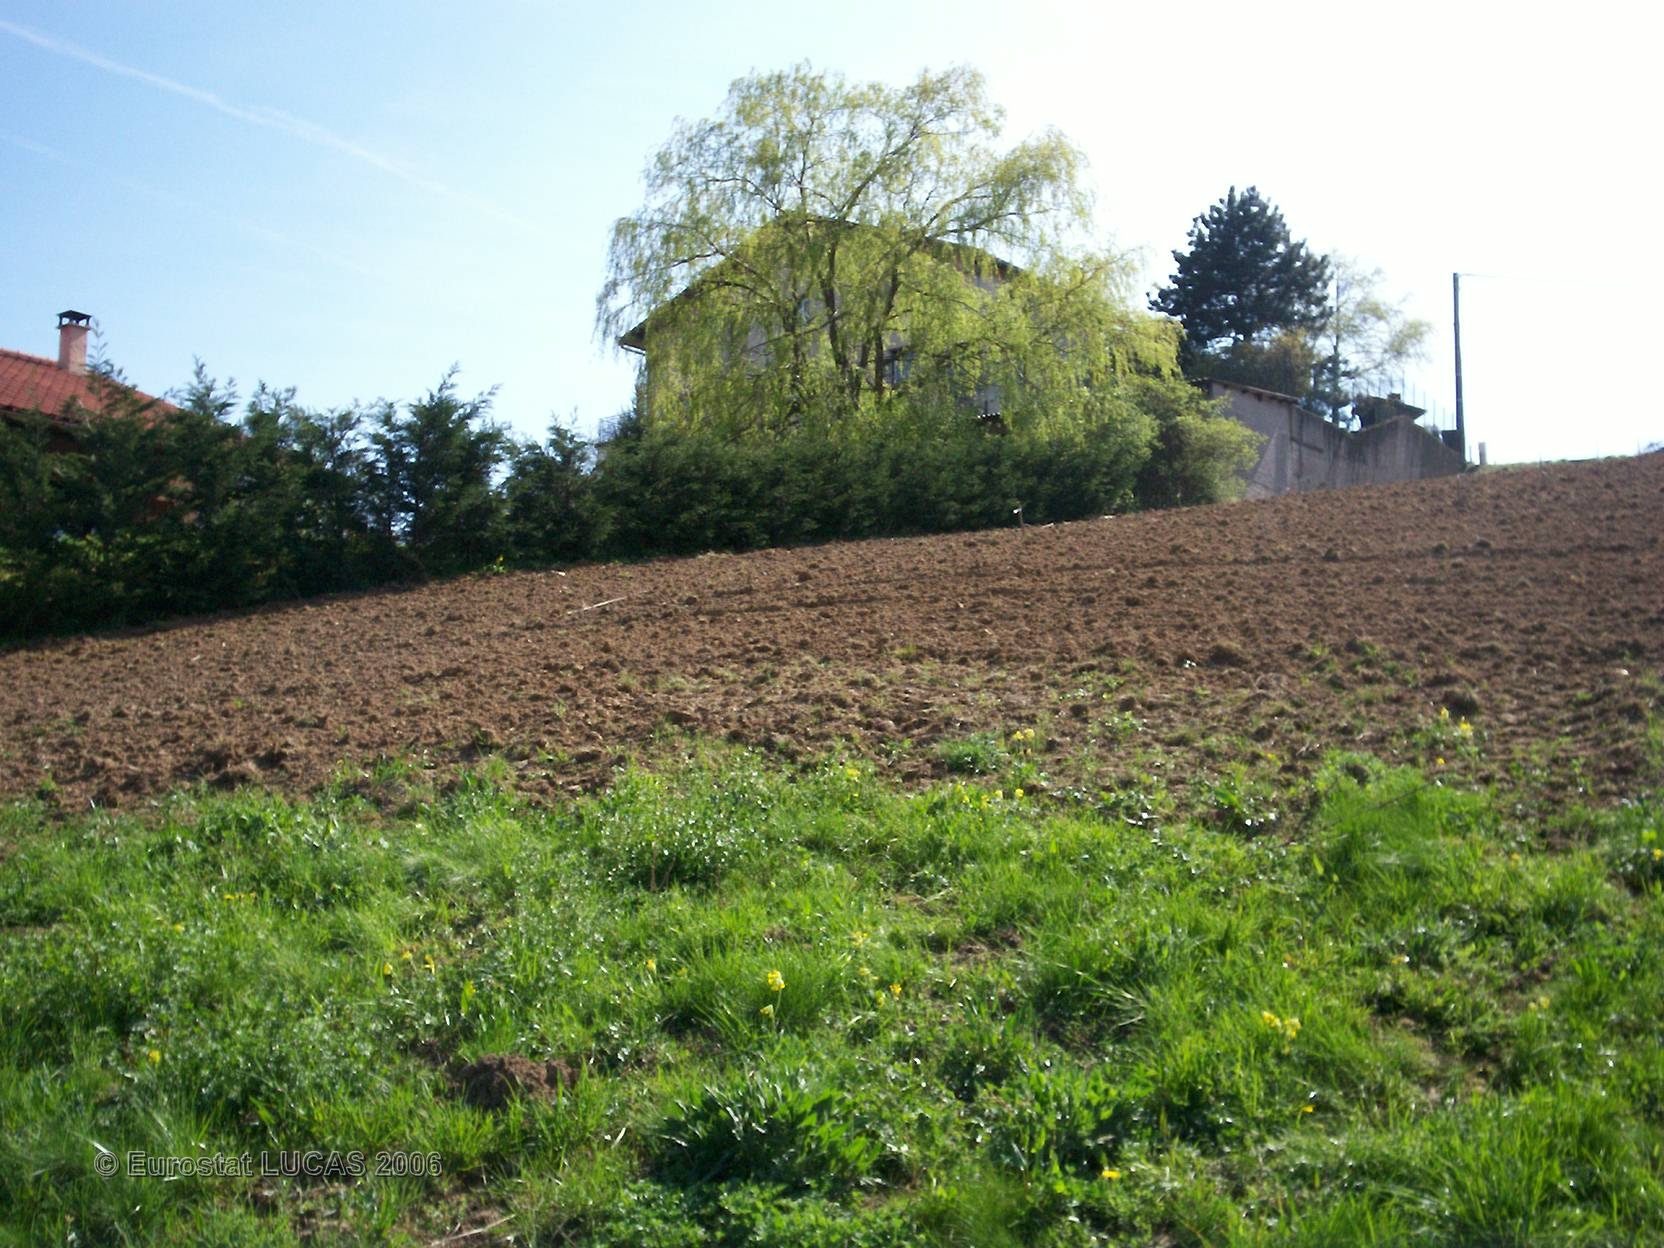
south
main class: Grassland
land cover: Grassland without tree/shrub cover
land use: Agriculture (excluding fallow land and kitchen gardens)
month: April
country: FR
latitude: 45.5384
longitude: 4.7919
